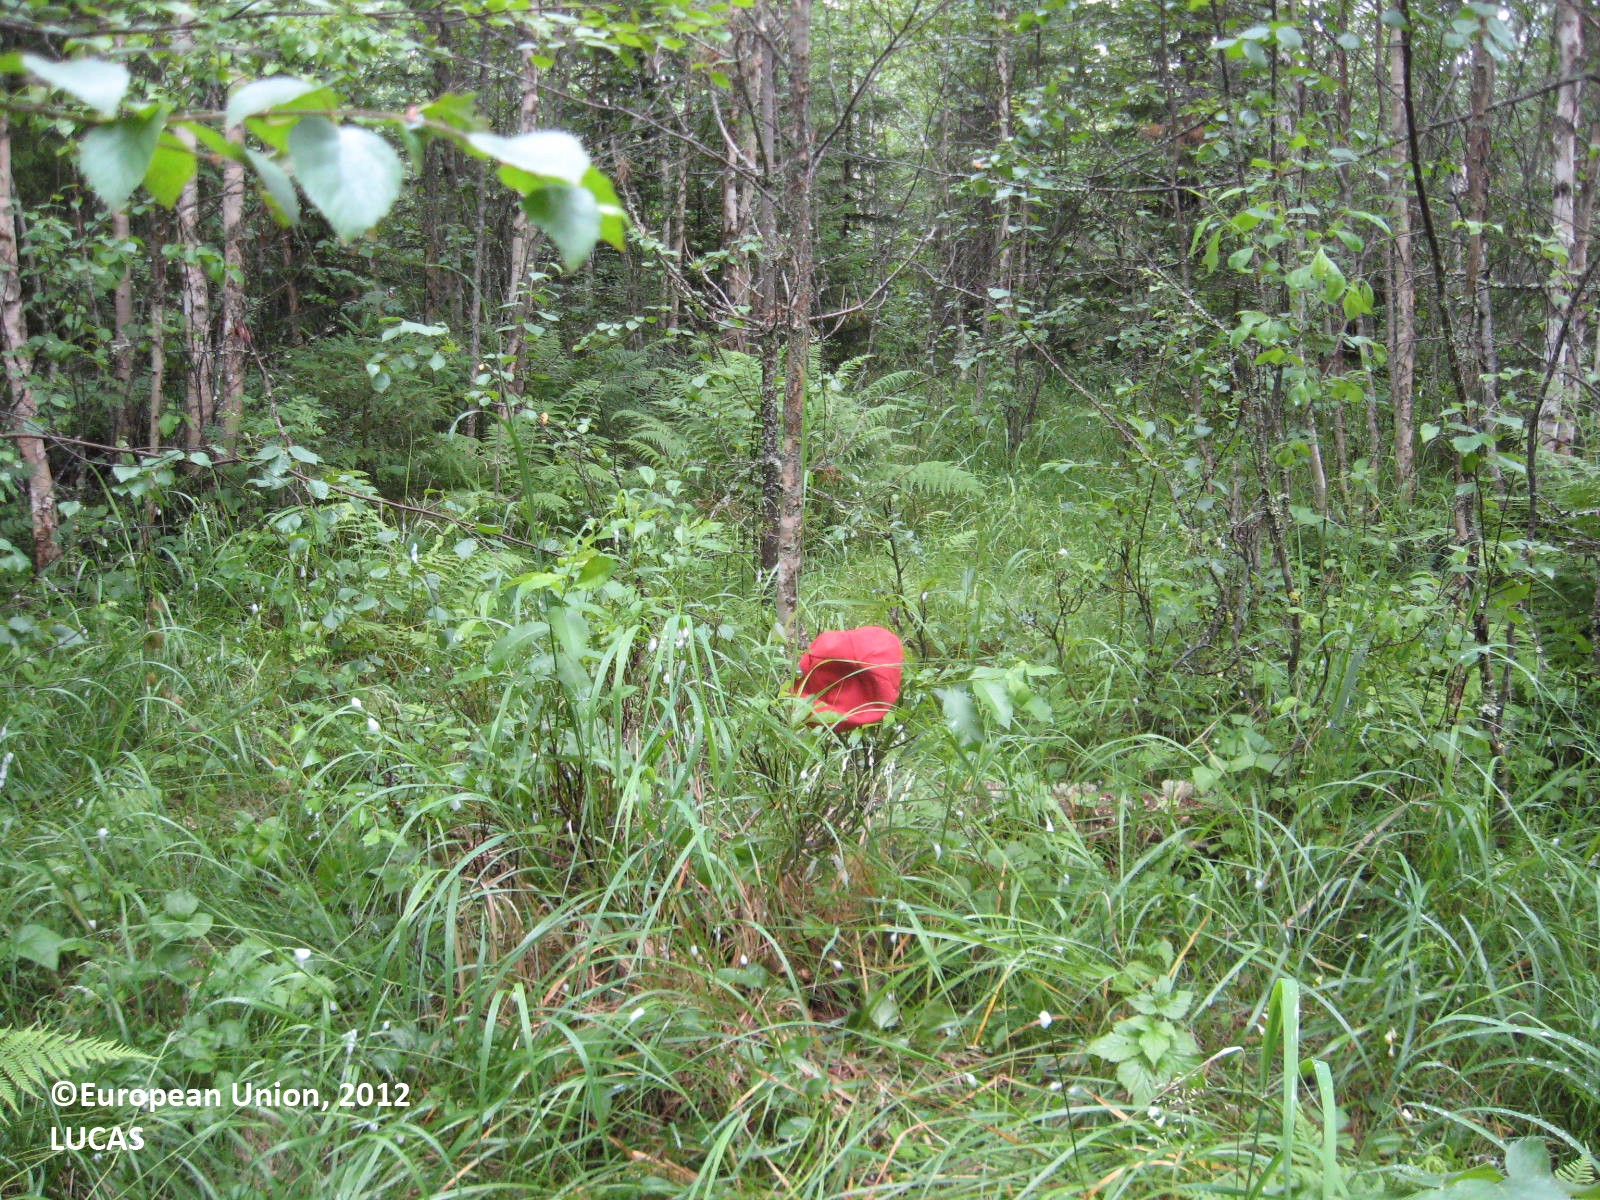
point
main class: Woodland
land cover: Other mixed woodland
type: boreal forest
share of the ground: > 75 %
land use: Forestry
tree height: > 5 m
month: July
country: FI
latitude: 62.3942
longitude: 21.6719
